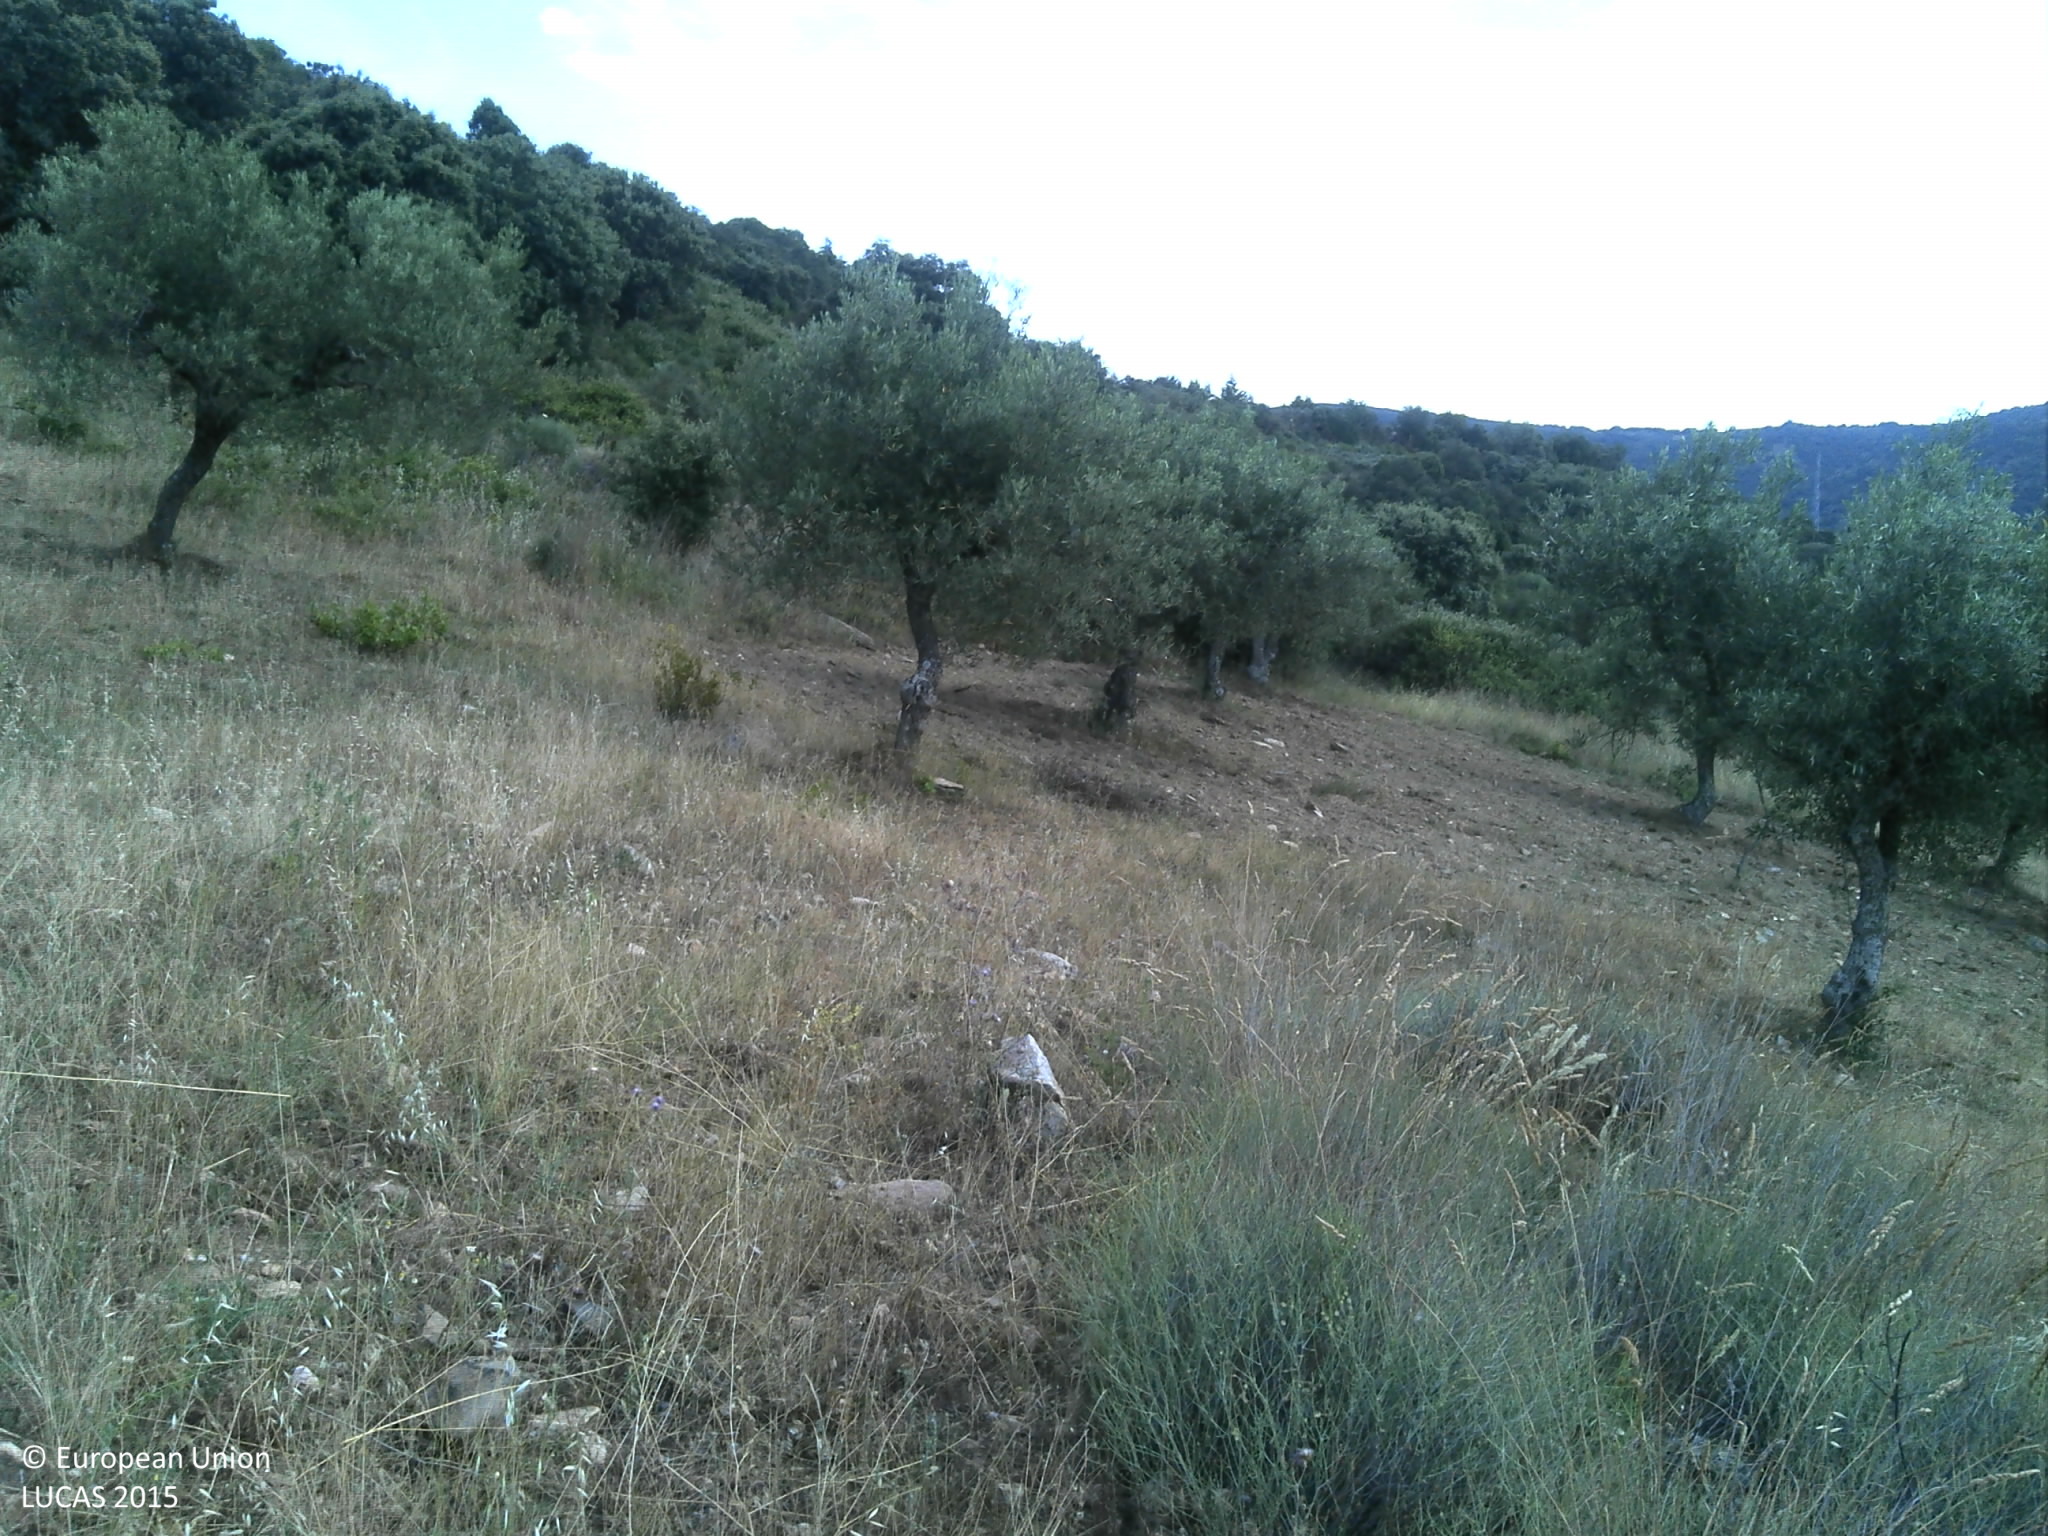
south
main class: Cropland
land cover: Olive groves
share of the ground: < 10 %
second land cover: Spontaneously vegetated surfaces
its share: 25 - 50 %
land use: Agriculture (excluding fallow land and kitchen gardens)
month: June
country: PT
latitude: 41.4800
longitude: -7.1106
